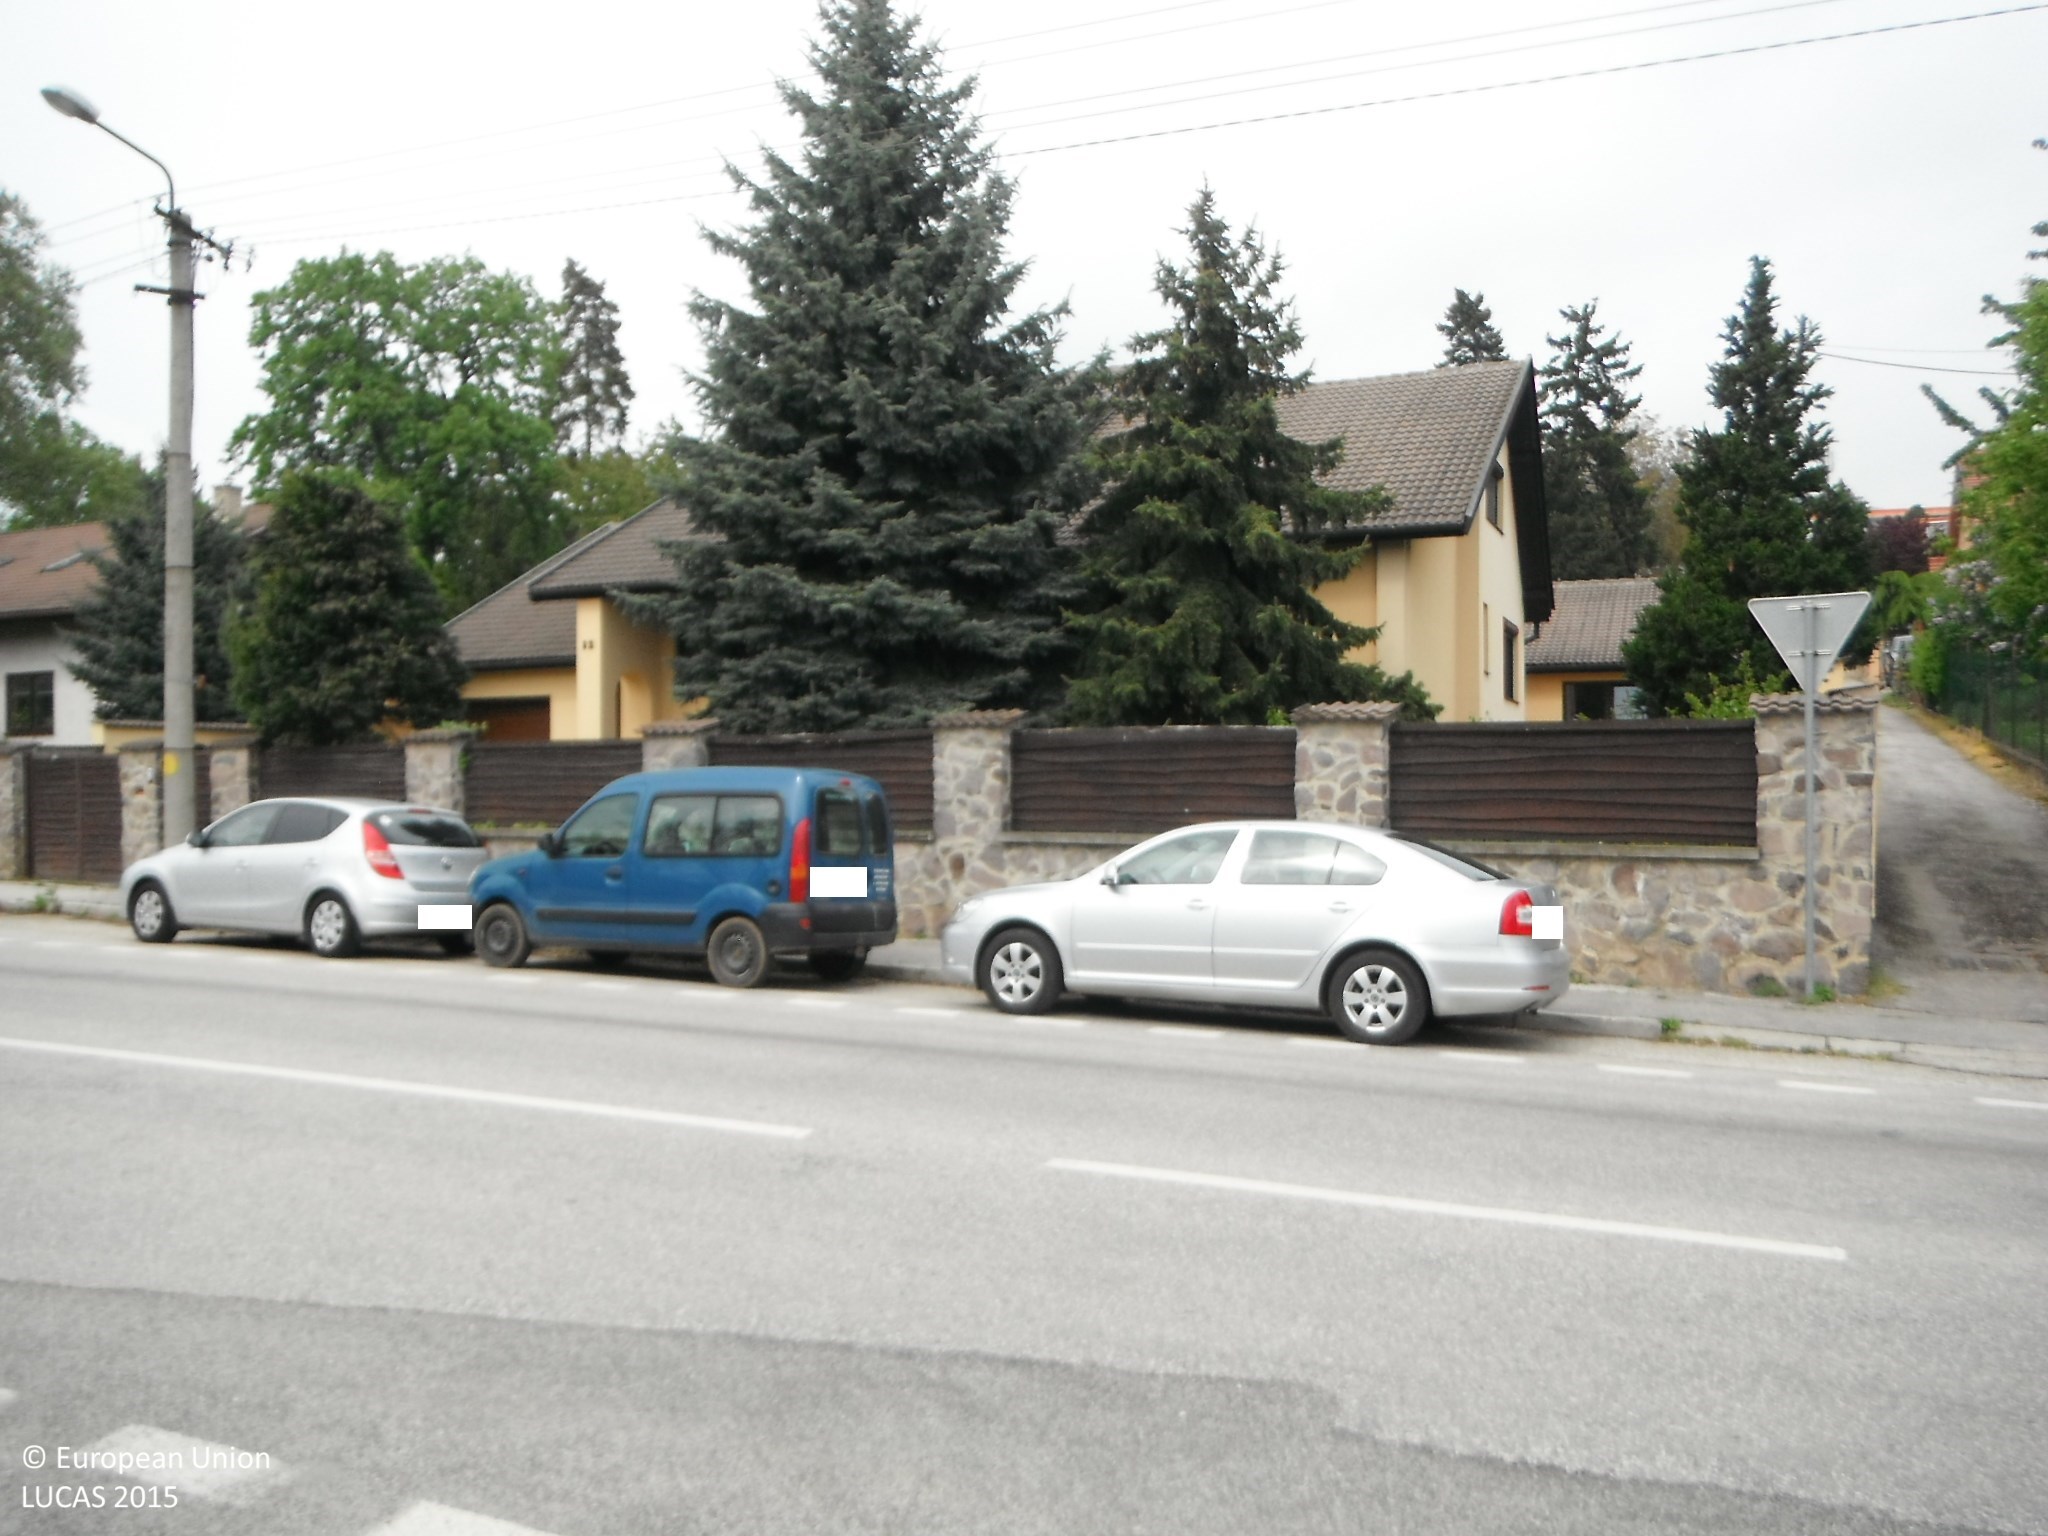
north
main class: Cropland
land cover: Other fruit trees and berries
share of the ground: > 75 %
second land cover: Grassland without tree/shrub cover
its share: > 75 %
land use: Kitchen garden
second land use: Amenities, museums, leisure
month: May
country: SK
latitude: 48.3235
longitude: 18.0924
